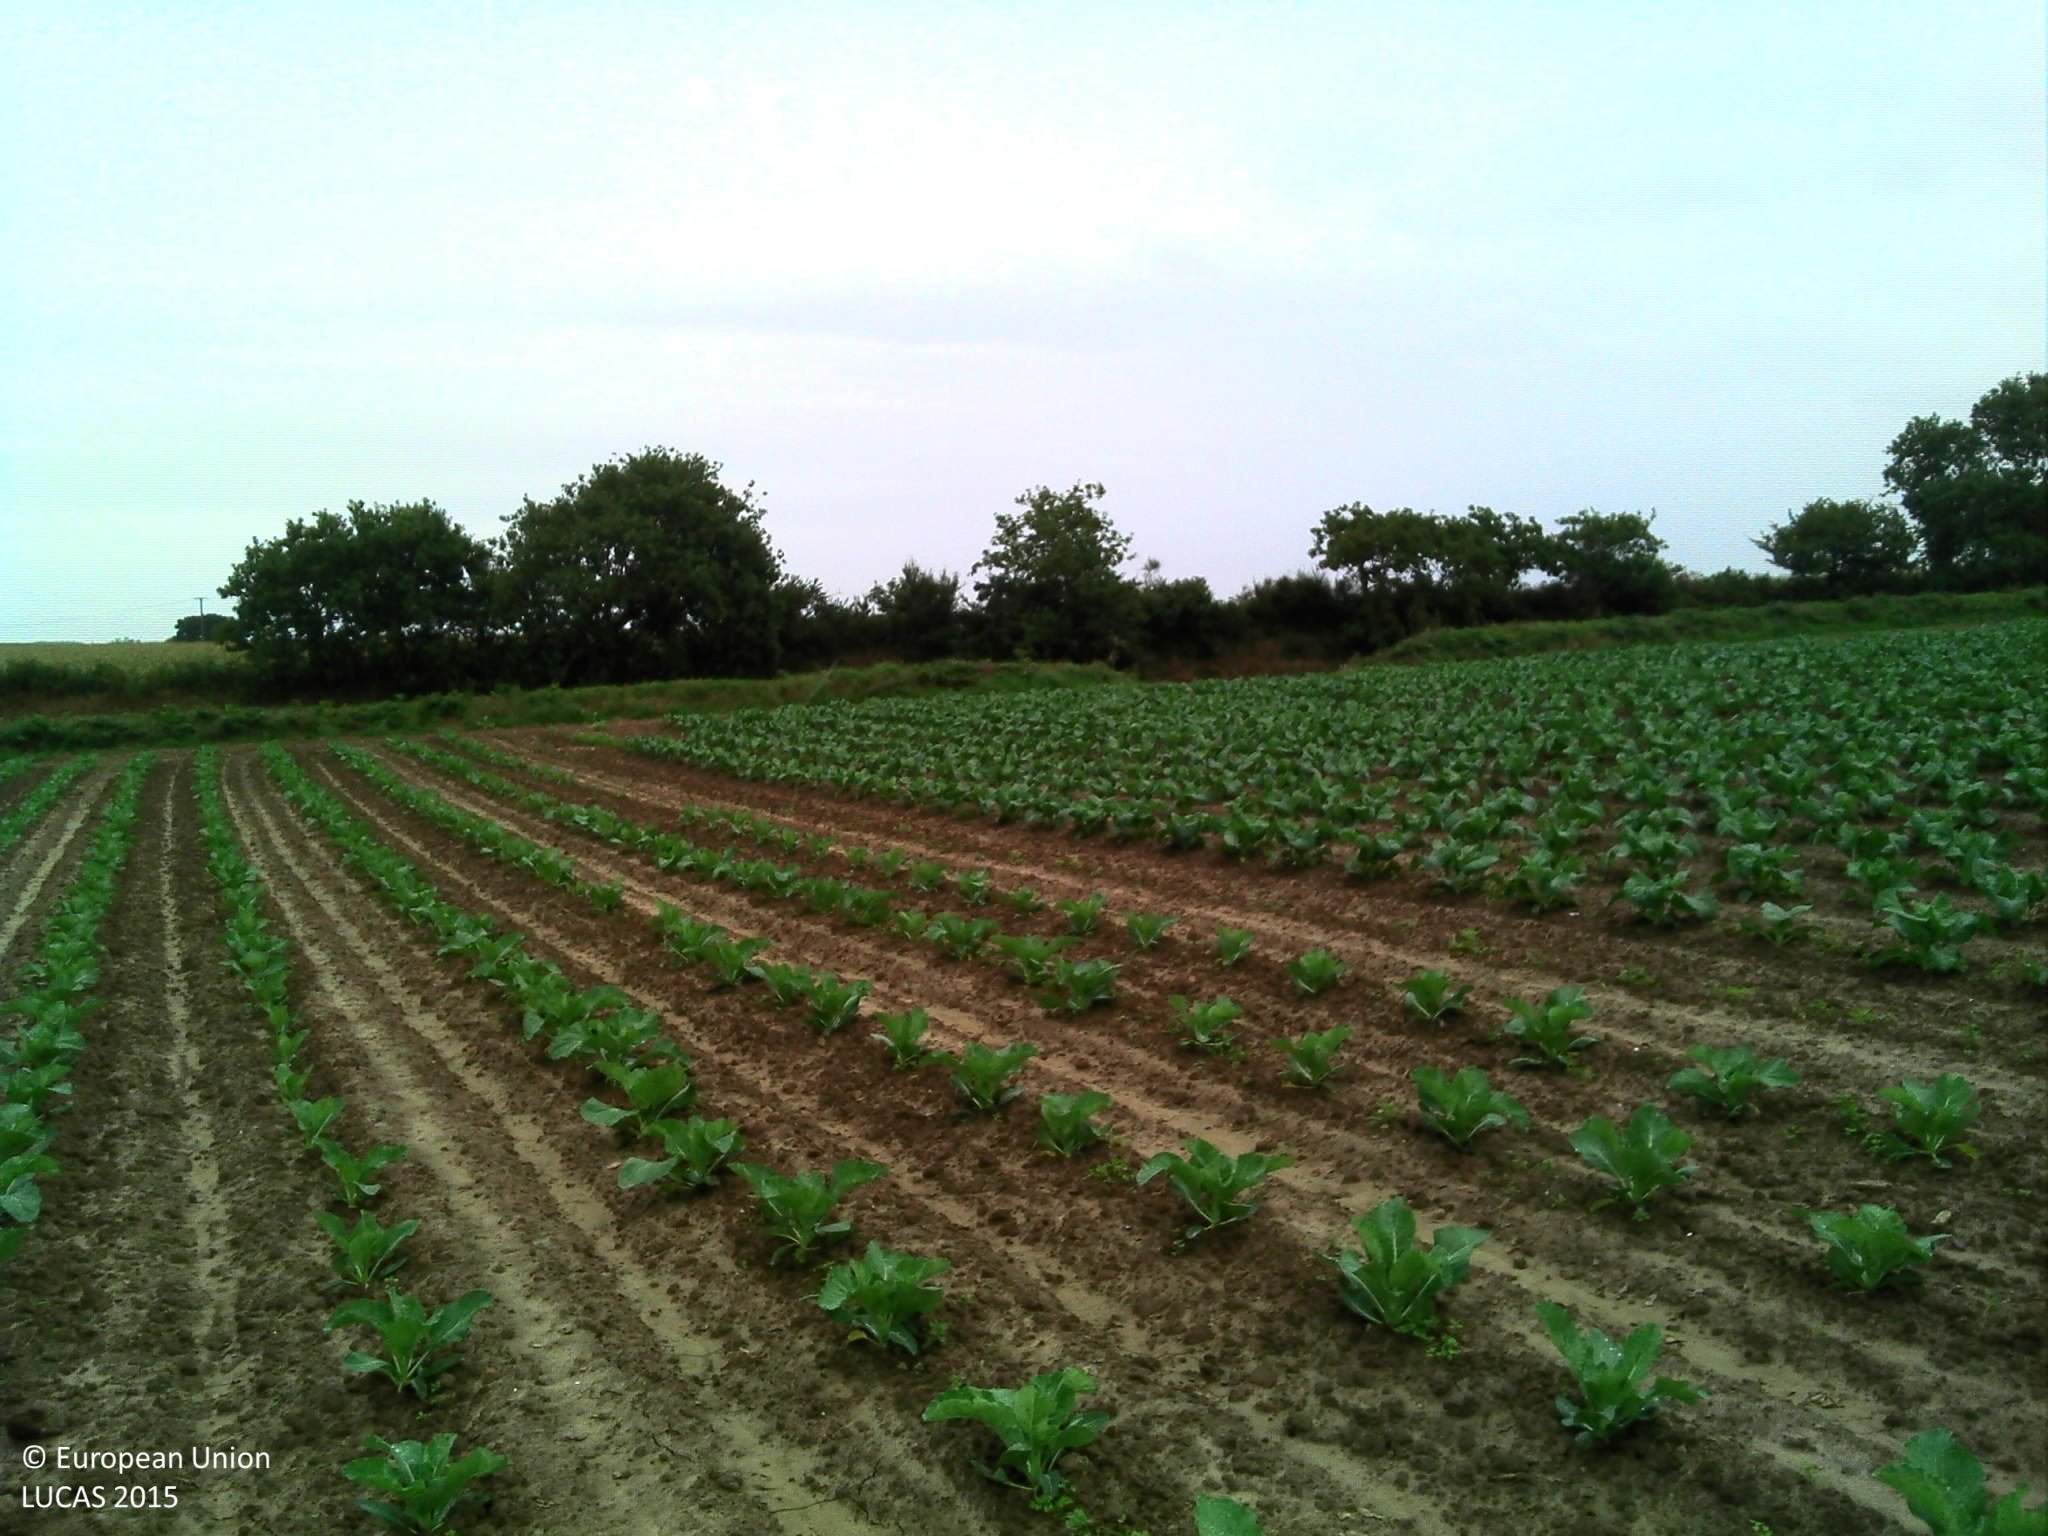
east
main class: Cropland
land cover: Other fresh vegetables
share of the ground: 10 - 25 %
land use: Agriculture (excluding fallow land and kitchen gardens)
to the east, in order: Other fresh vegetables; Abandoned hedges; Grass margins; Ditches and canals; Grass margins; Tracks; Grass margins; Ditches and canals; Abandoned hedges; Lines of trees; Maize; Abandoned hedges; Common wheat
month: August
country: FR
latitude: 48.7995
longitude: -3.2957
